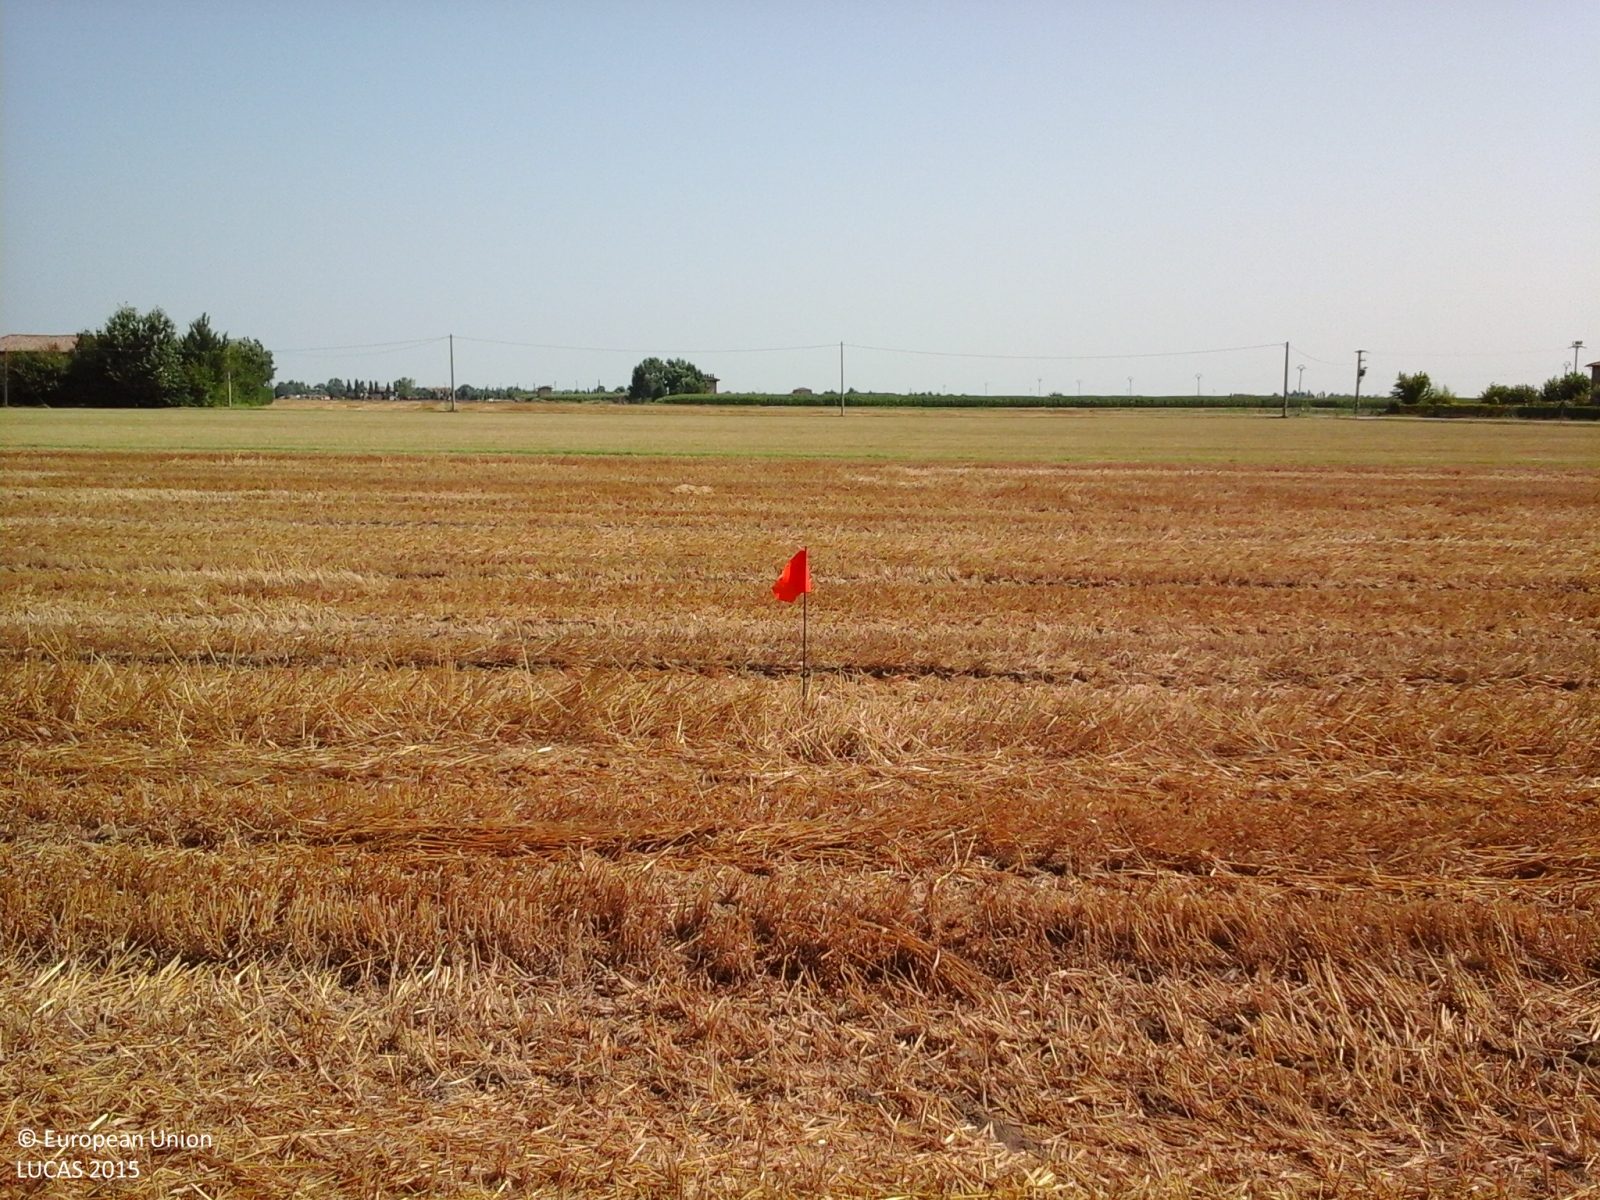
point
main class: Cropland
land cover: Common wheat
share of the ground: > 75 %
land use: Agriculture (excluding fallow land and kitchen gardens)
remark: Harvested field
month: July
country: IT
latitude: 44.5183
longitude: 11.6195
